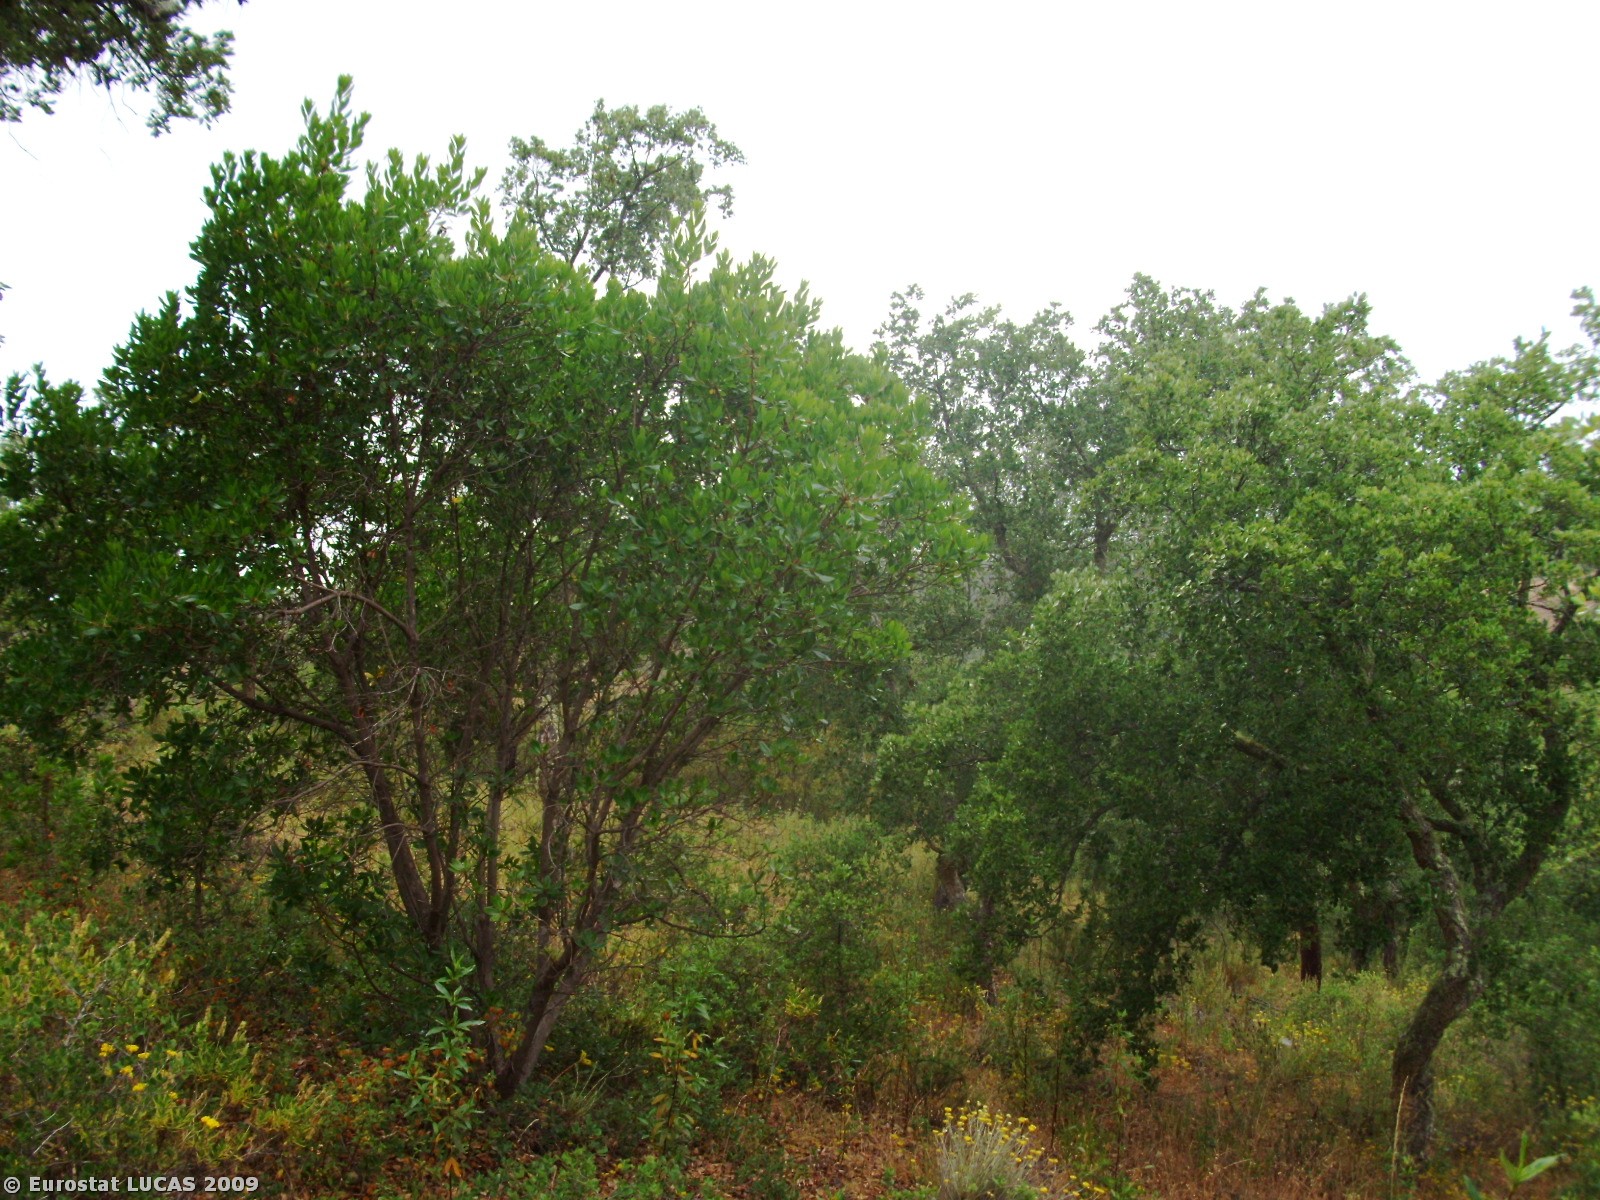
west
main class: Woodland
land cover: Broadleaved woodland
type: broadleaved evergreen forest
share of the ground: 10 - 25 %
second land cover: Spontaneously vegetated surfaces
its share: 50 - 75 %
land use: Forestry
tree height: > 5 m
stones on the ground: 10 - 25 %
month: June
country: PT
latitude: 37.5342
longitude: -8.4672
